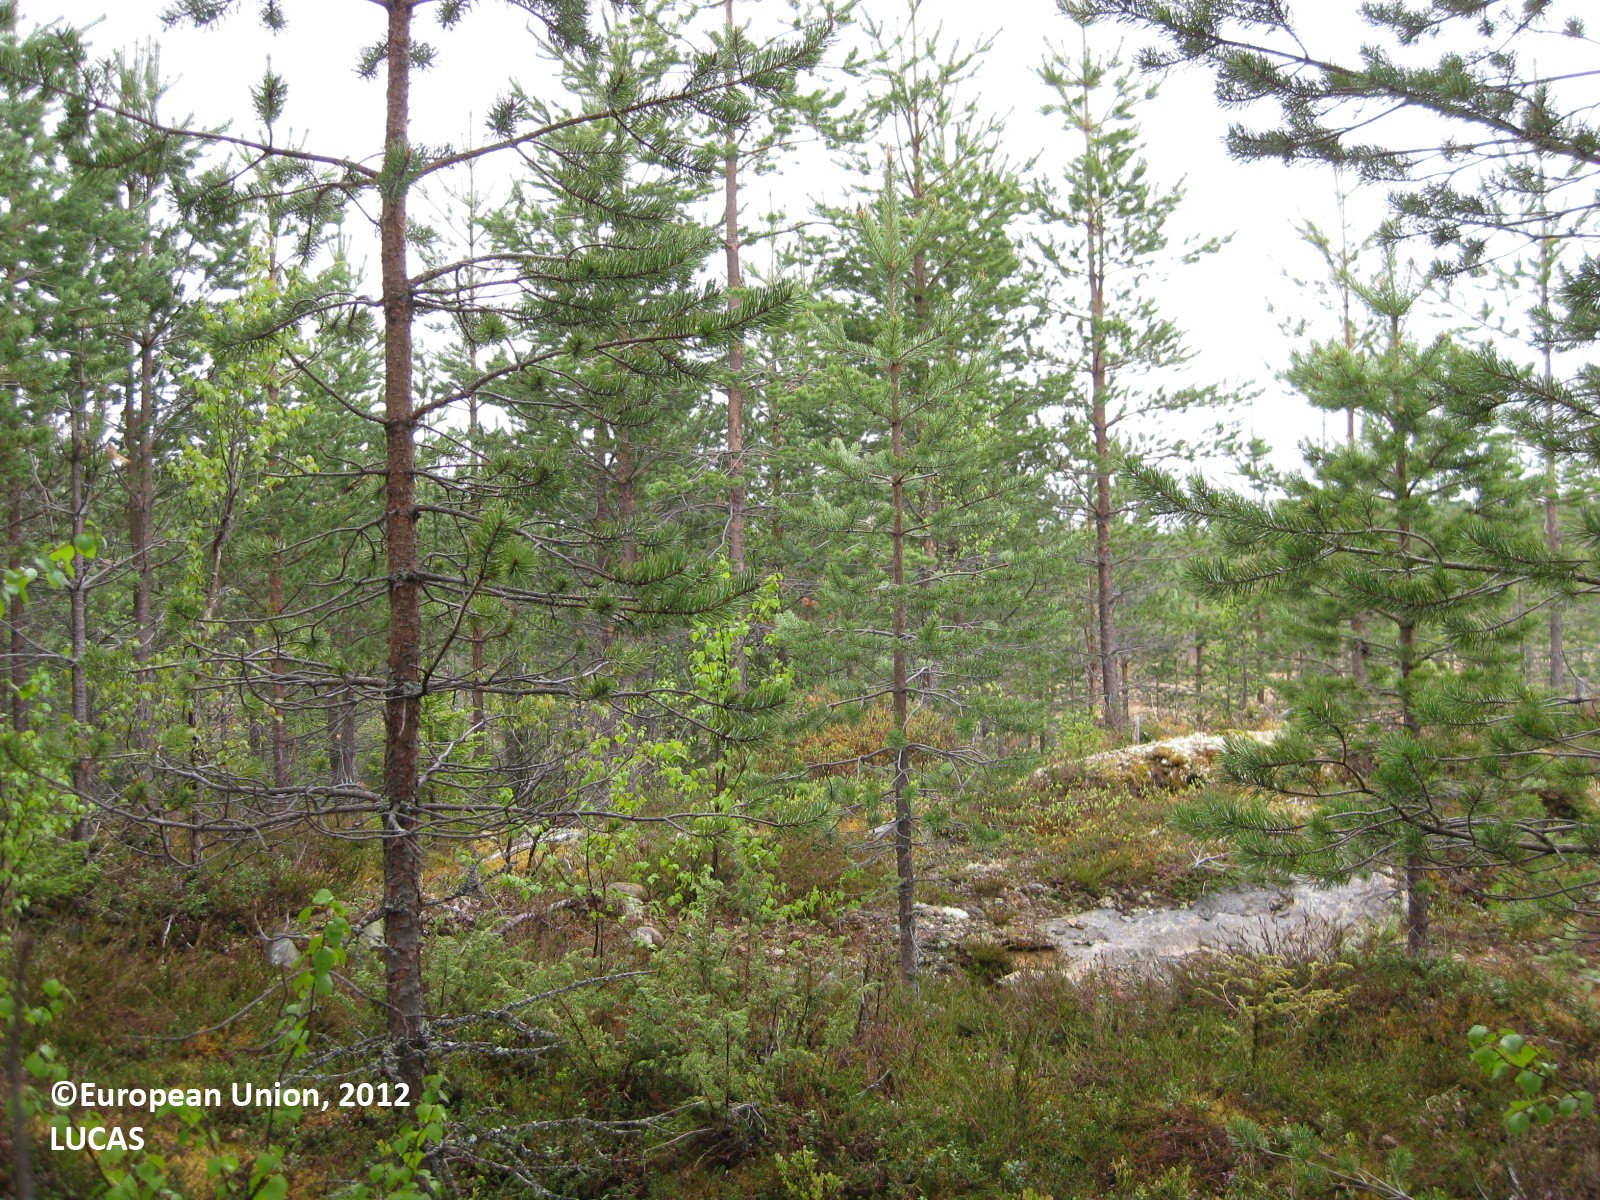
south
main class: Woodland
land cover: Pine dominated coniferous woodland
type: boreal forest
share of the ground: > 75 %
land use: Forestry
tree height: > 5 m
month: June
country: FI
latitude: 65.2637
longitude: 29.2322
